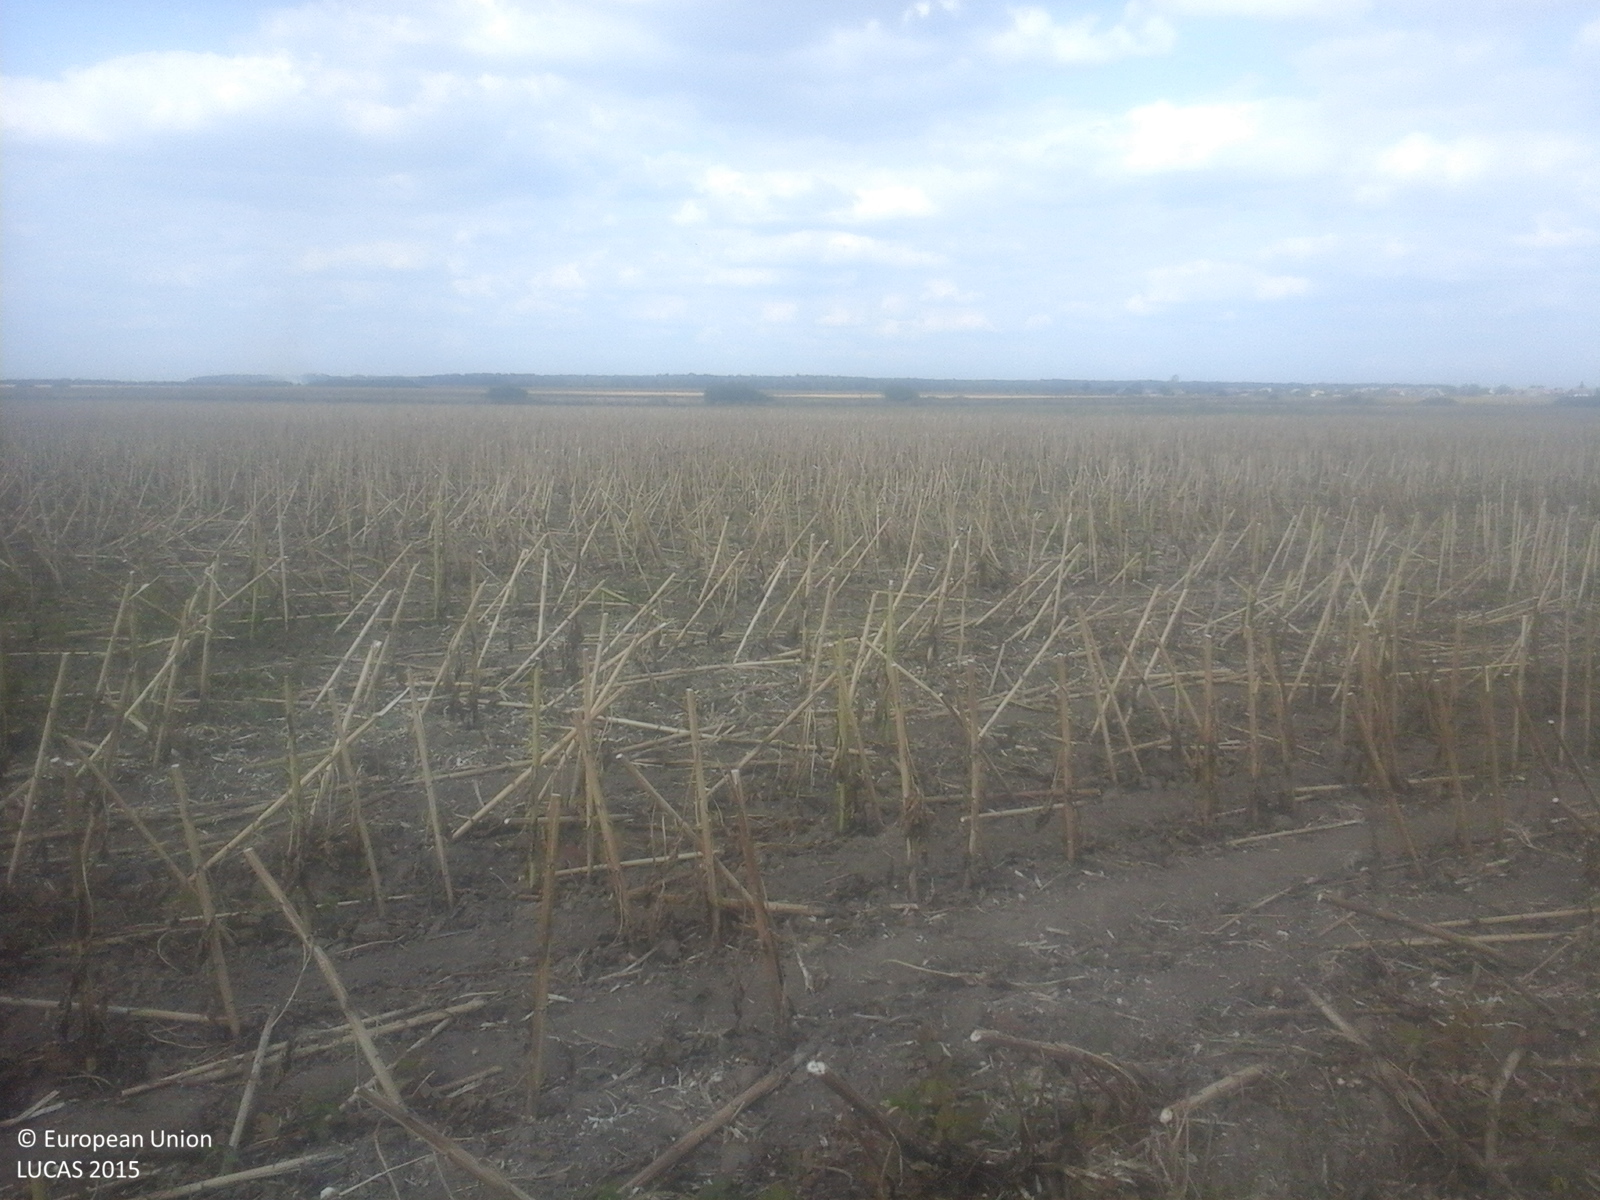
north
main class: Cropland
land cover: Sunflower
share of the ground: > 75 %
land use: Agriculture (excluding fallow land and kitchen gardens)
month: September
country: RO
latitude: 47.6677
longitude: 22.6994
